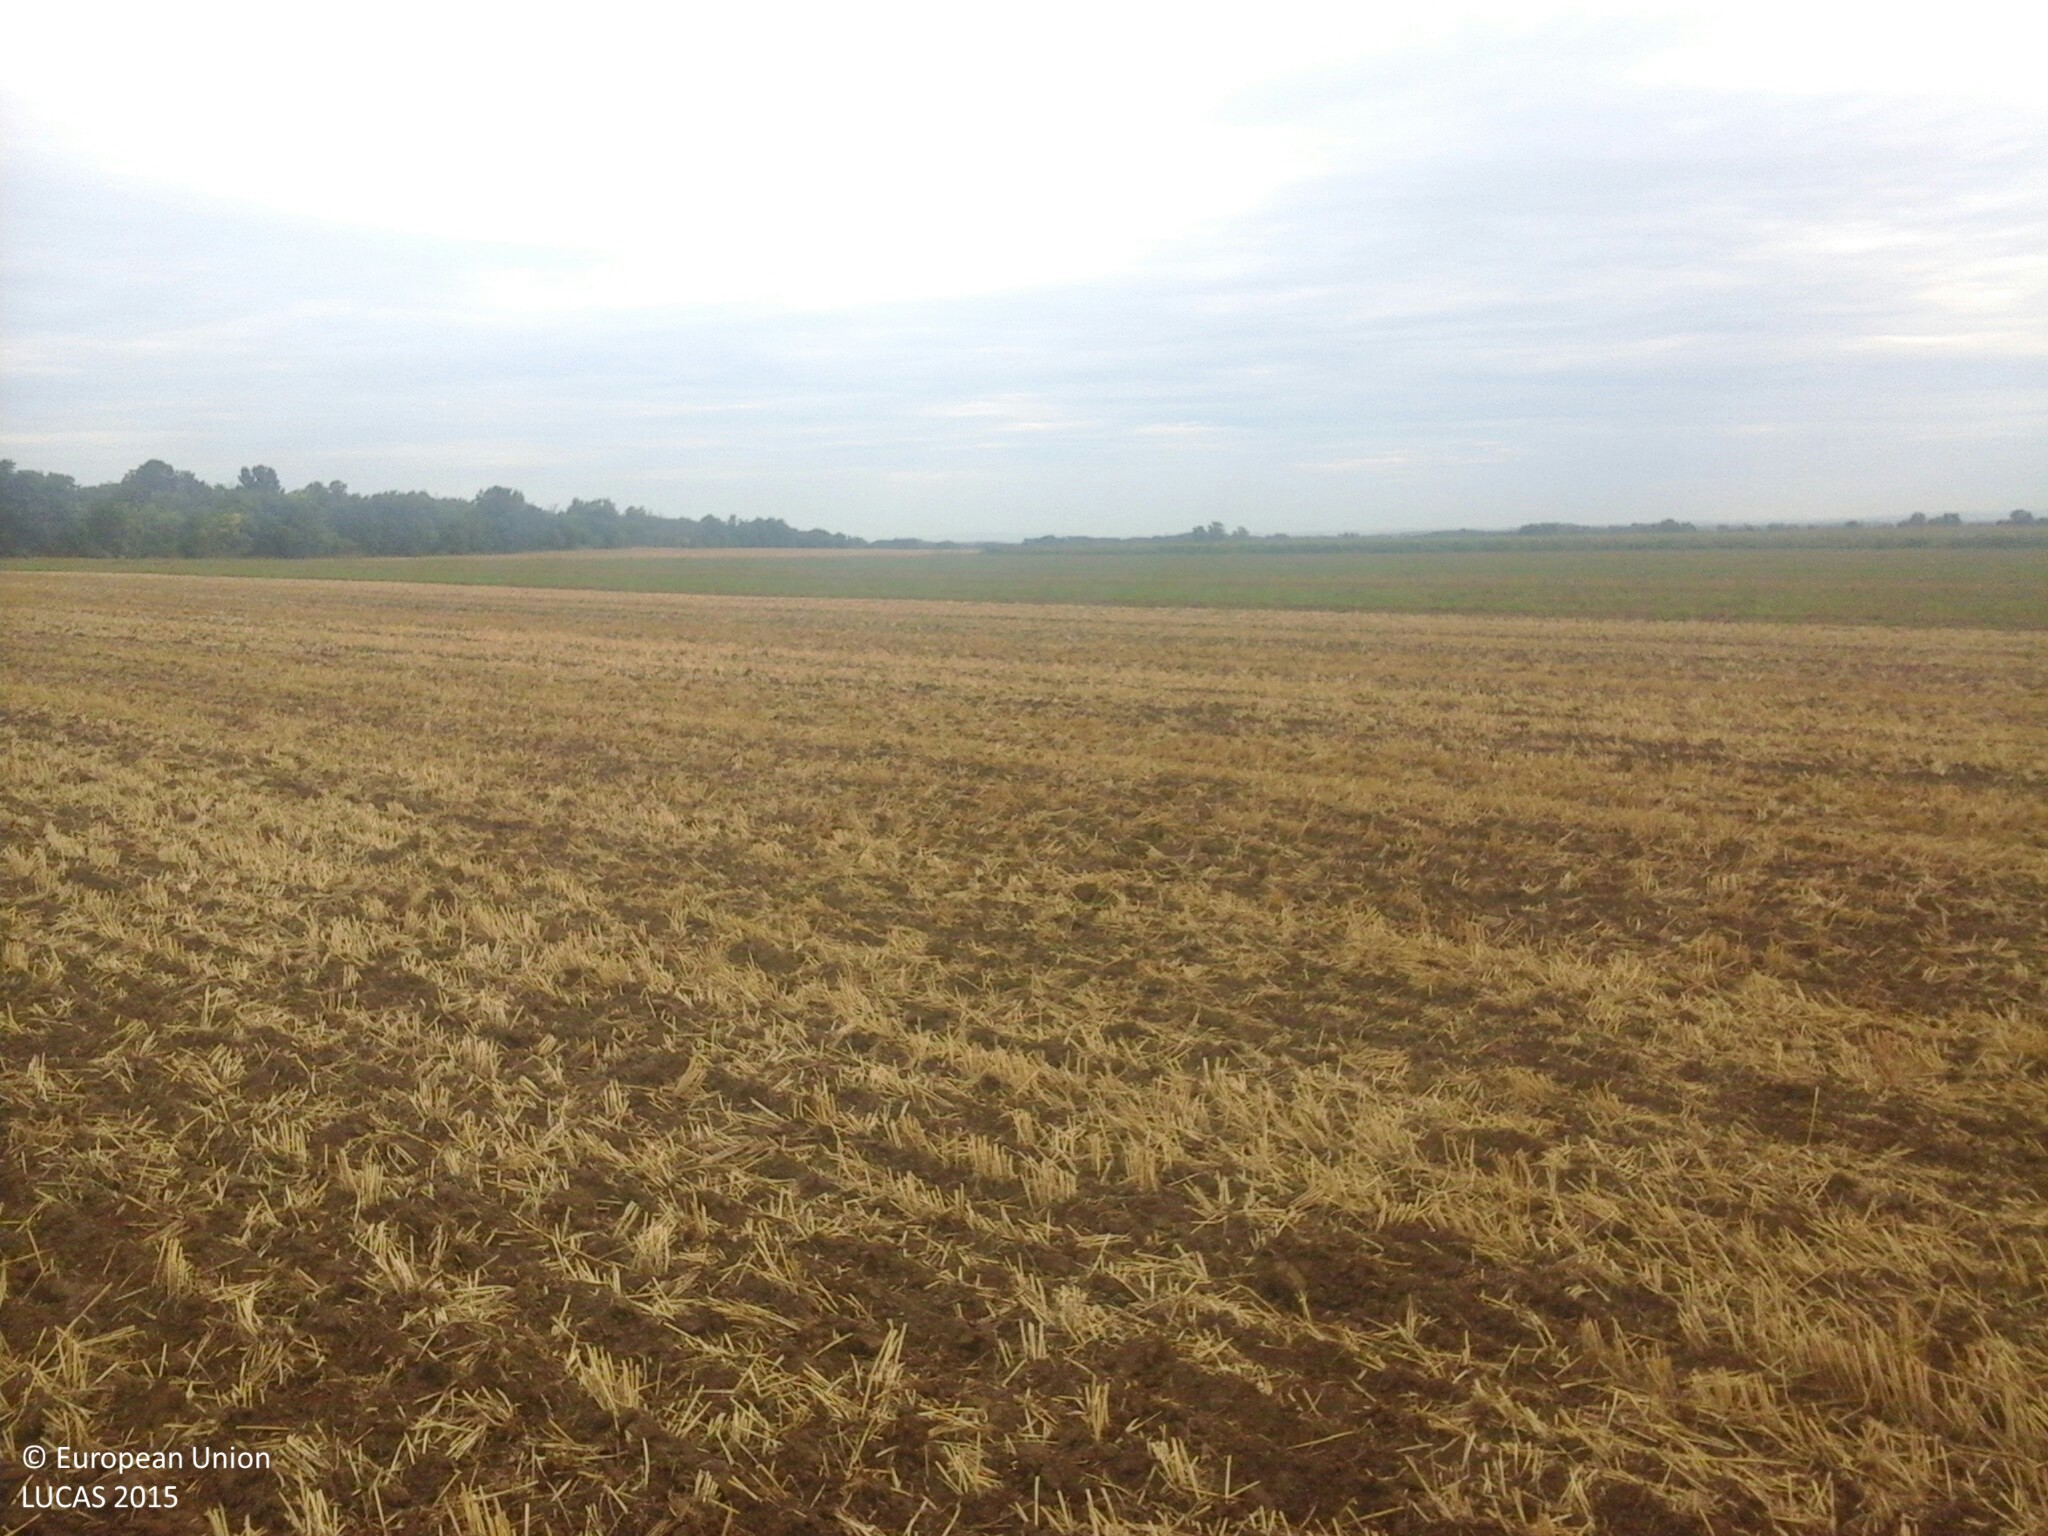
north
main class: Cropland
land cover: Oats
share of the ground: < 10 %
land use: Agriculture (excluding fallow land and kitchen gardens)
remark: Harvested field
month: July
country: HU
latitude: 47.0723
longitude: 18.3738
